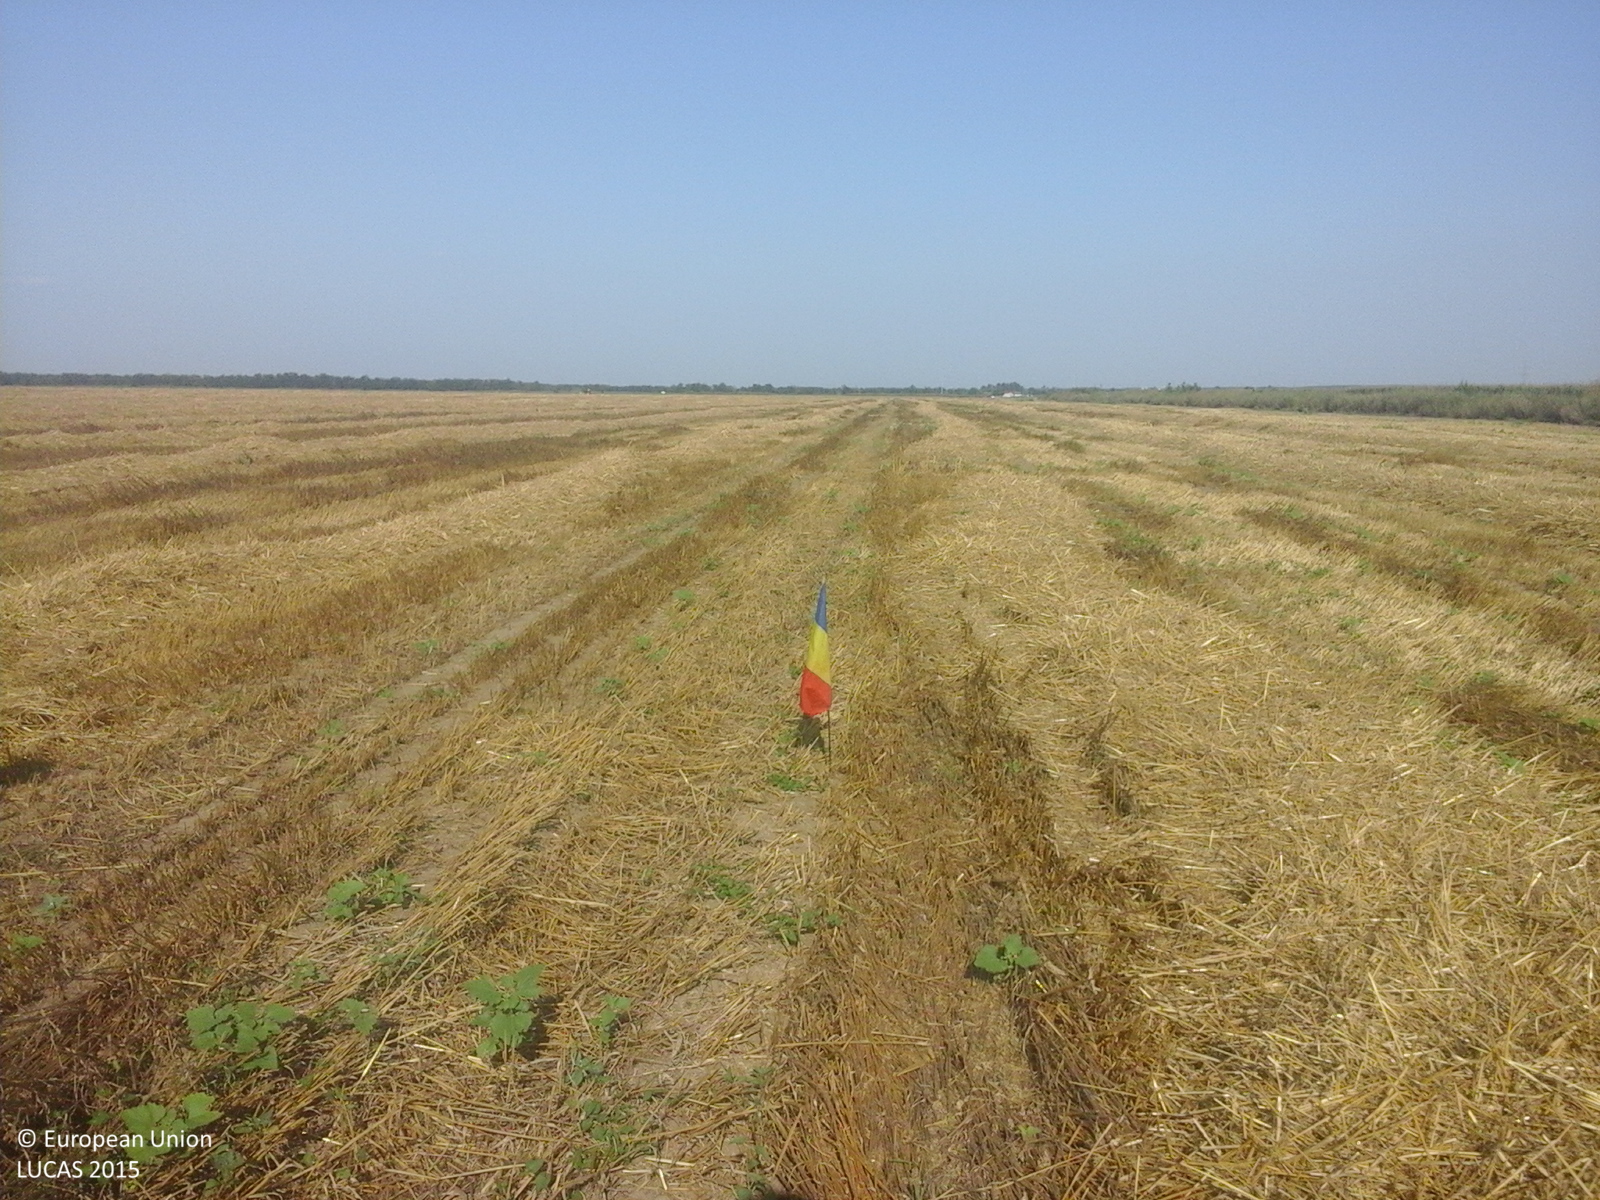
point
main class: Cropland
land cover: Common wheat
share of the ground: 10 - 25 %
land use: Agriculture (excluding fallow land and kitchen gardens)
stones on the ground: < 10 %
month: July
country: RO
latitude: 44.2252
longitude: 27.4255
